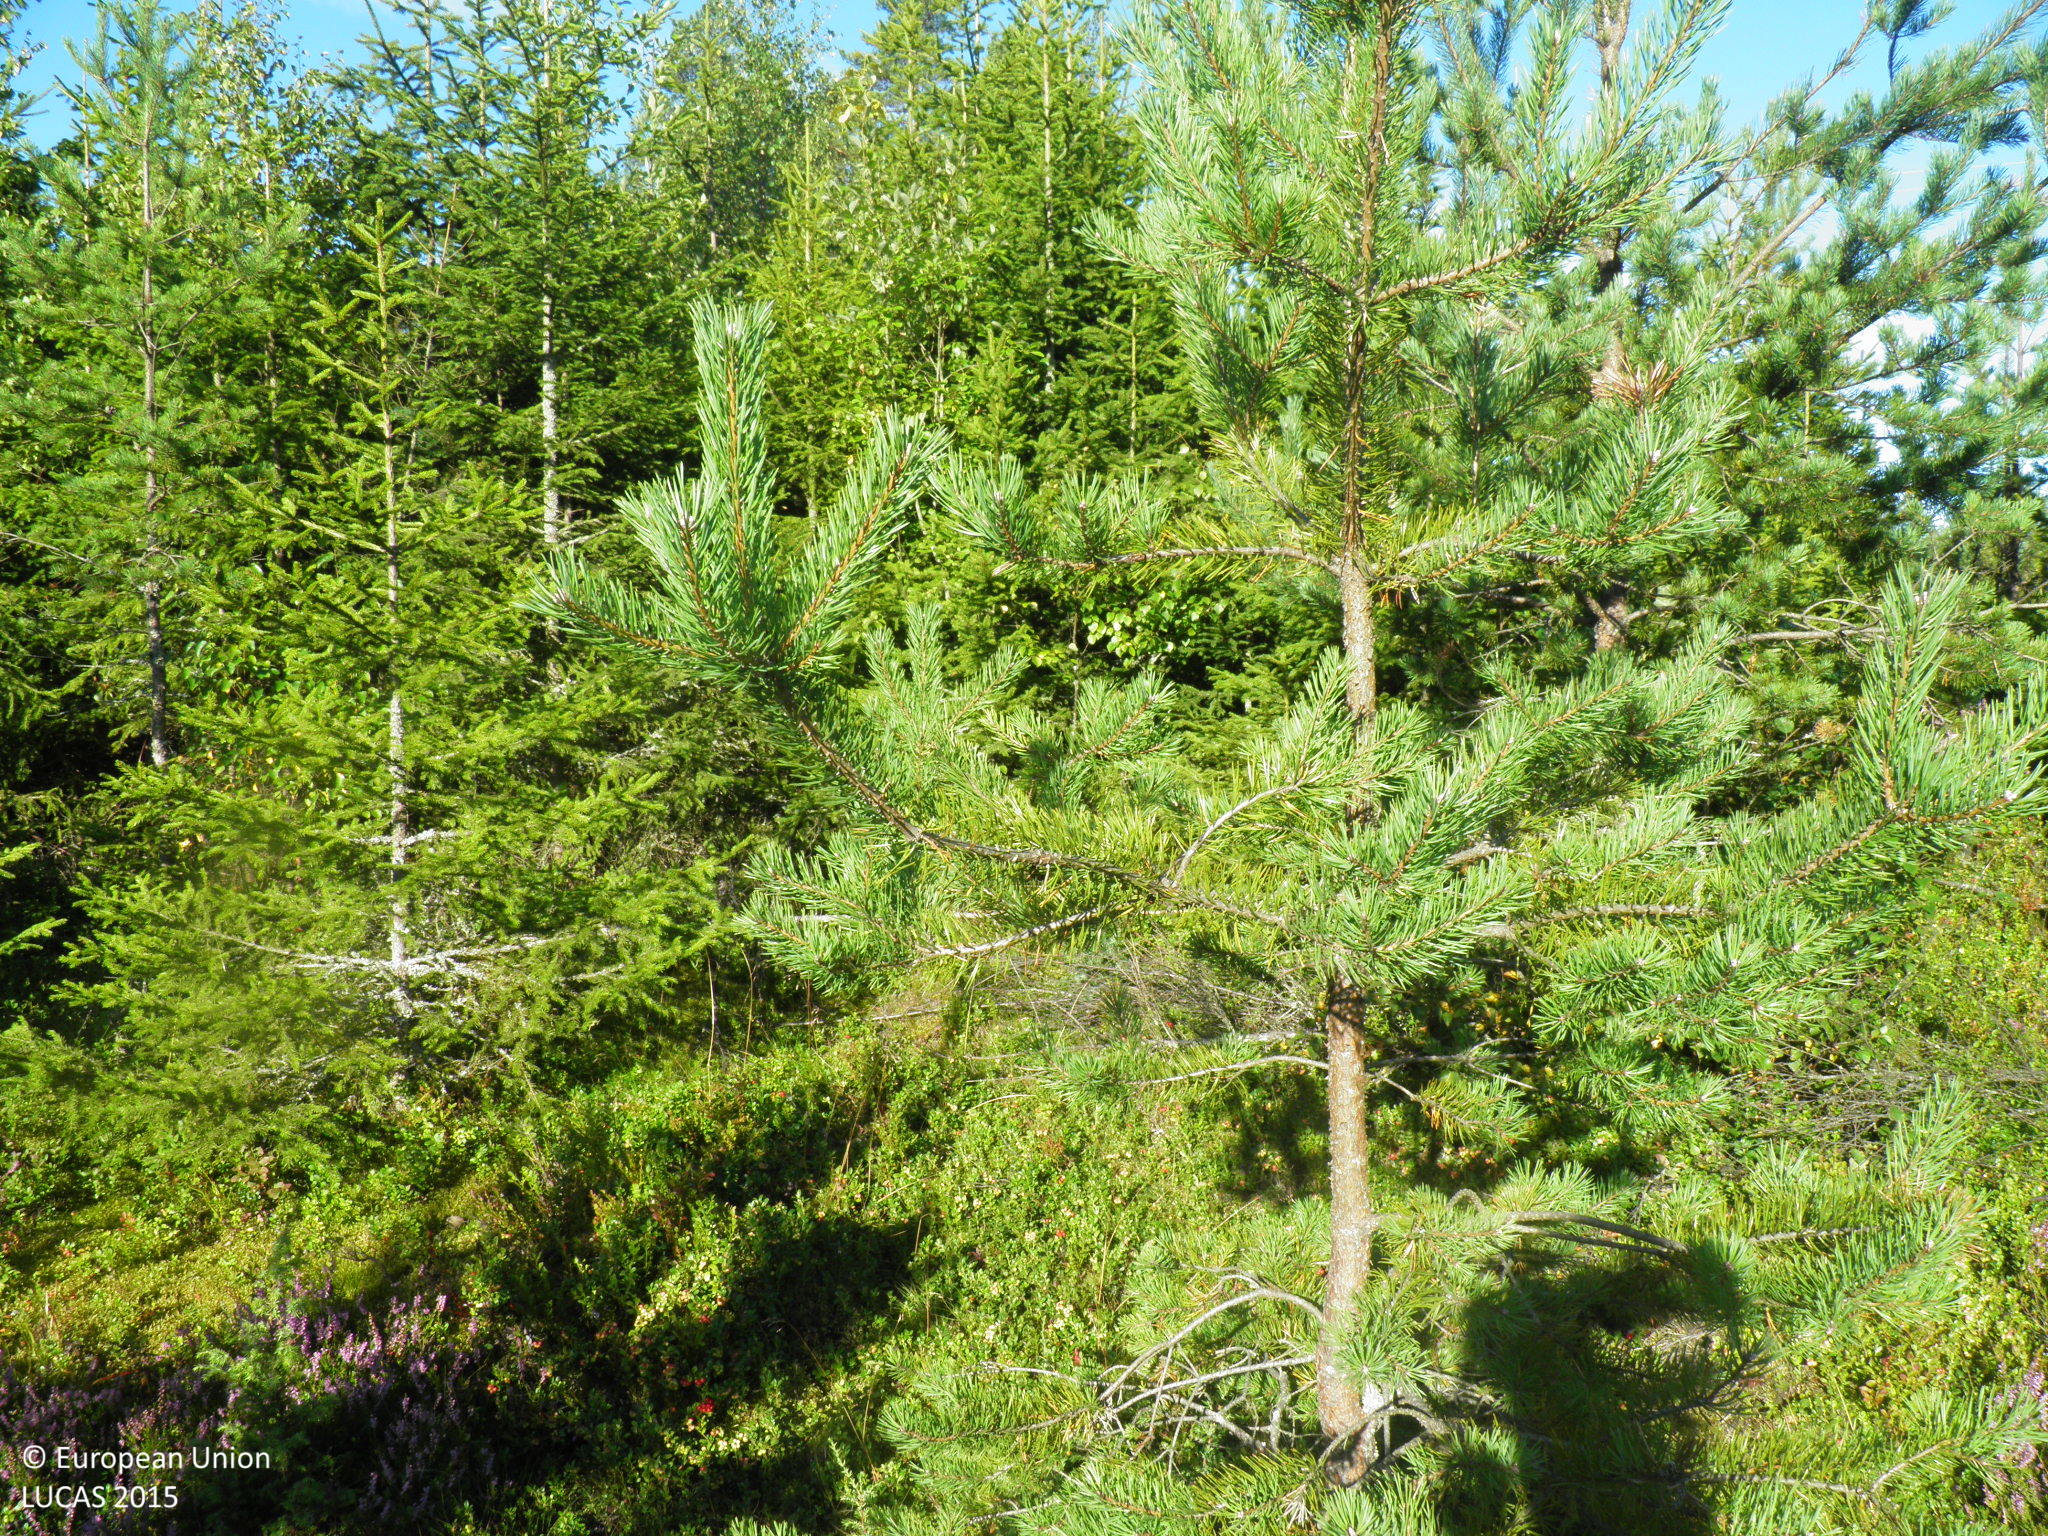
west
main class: Woodland
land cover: Other mixed woodland
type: hemiboreal forest and nemoral coniferous forest and mixed broadleaved-coniferous forest
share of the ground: 10 - 25 %
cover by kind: shrubs 40 %, herbaceous plants 20 %, lichens and mosses 20 %, coniferous forest trees 10 %, broadleaved forest trees 10 %
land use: Forestry
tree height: < 5 m
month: August
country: FI
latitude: 60.8431
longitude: 21.4437
